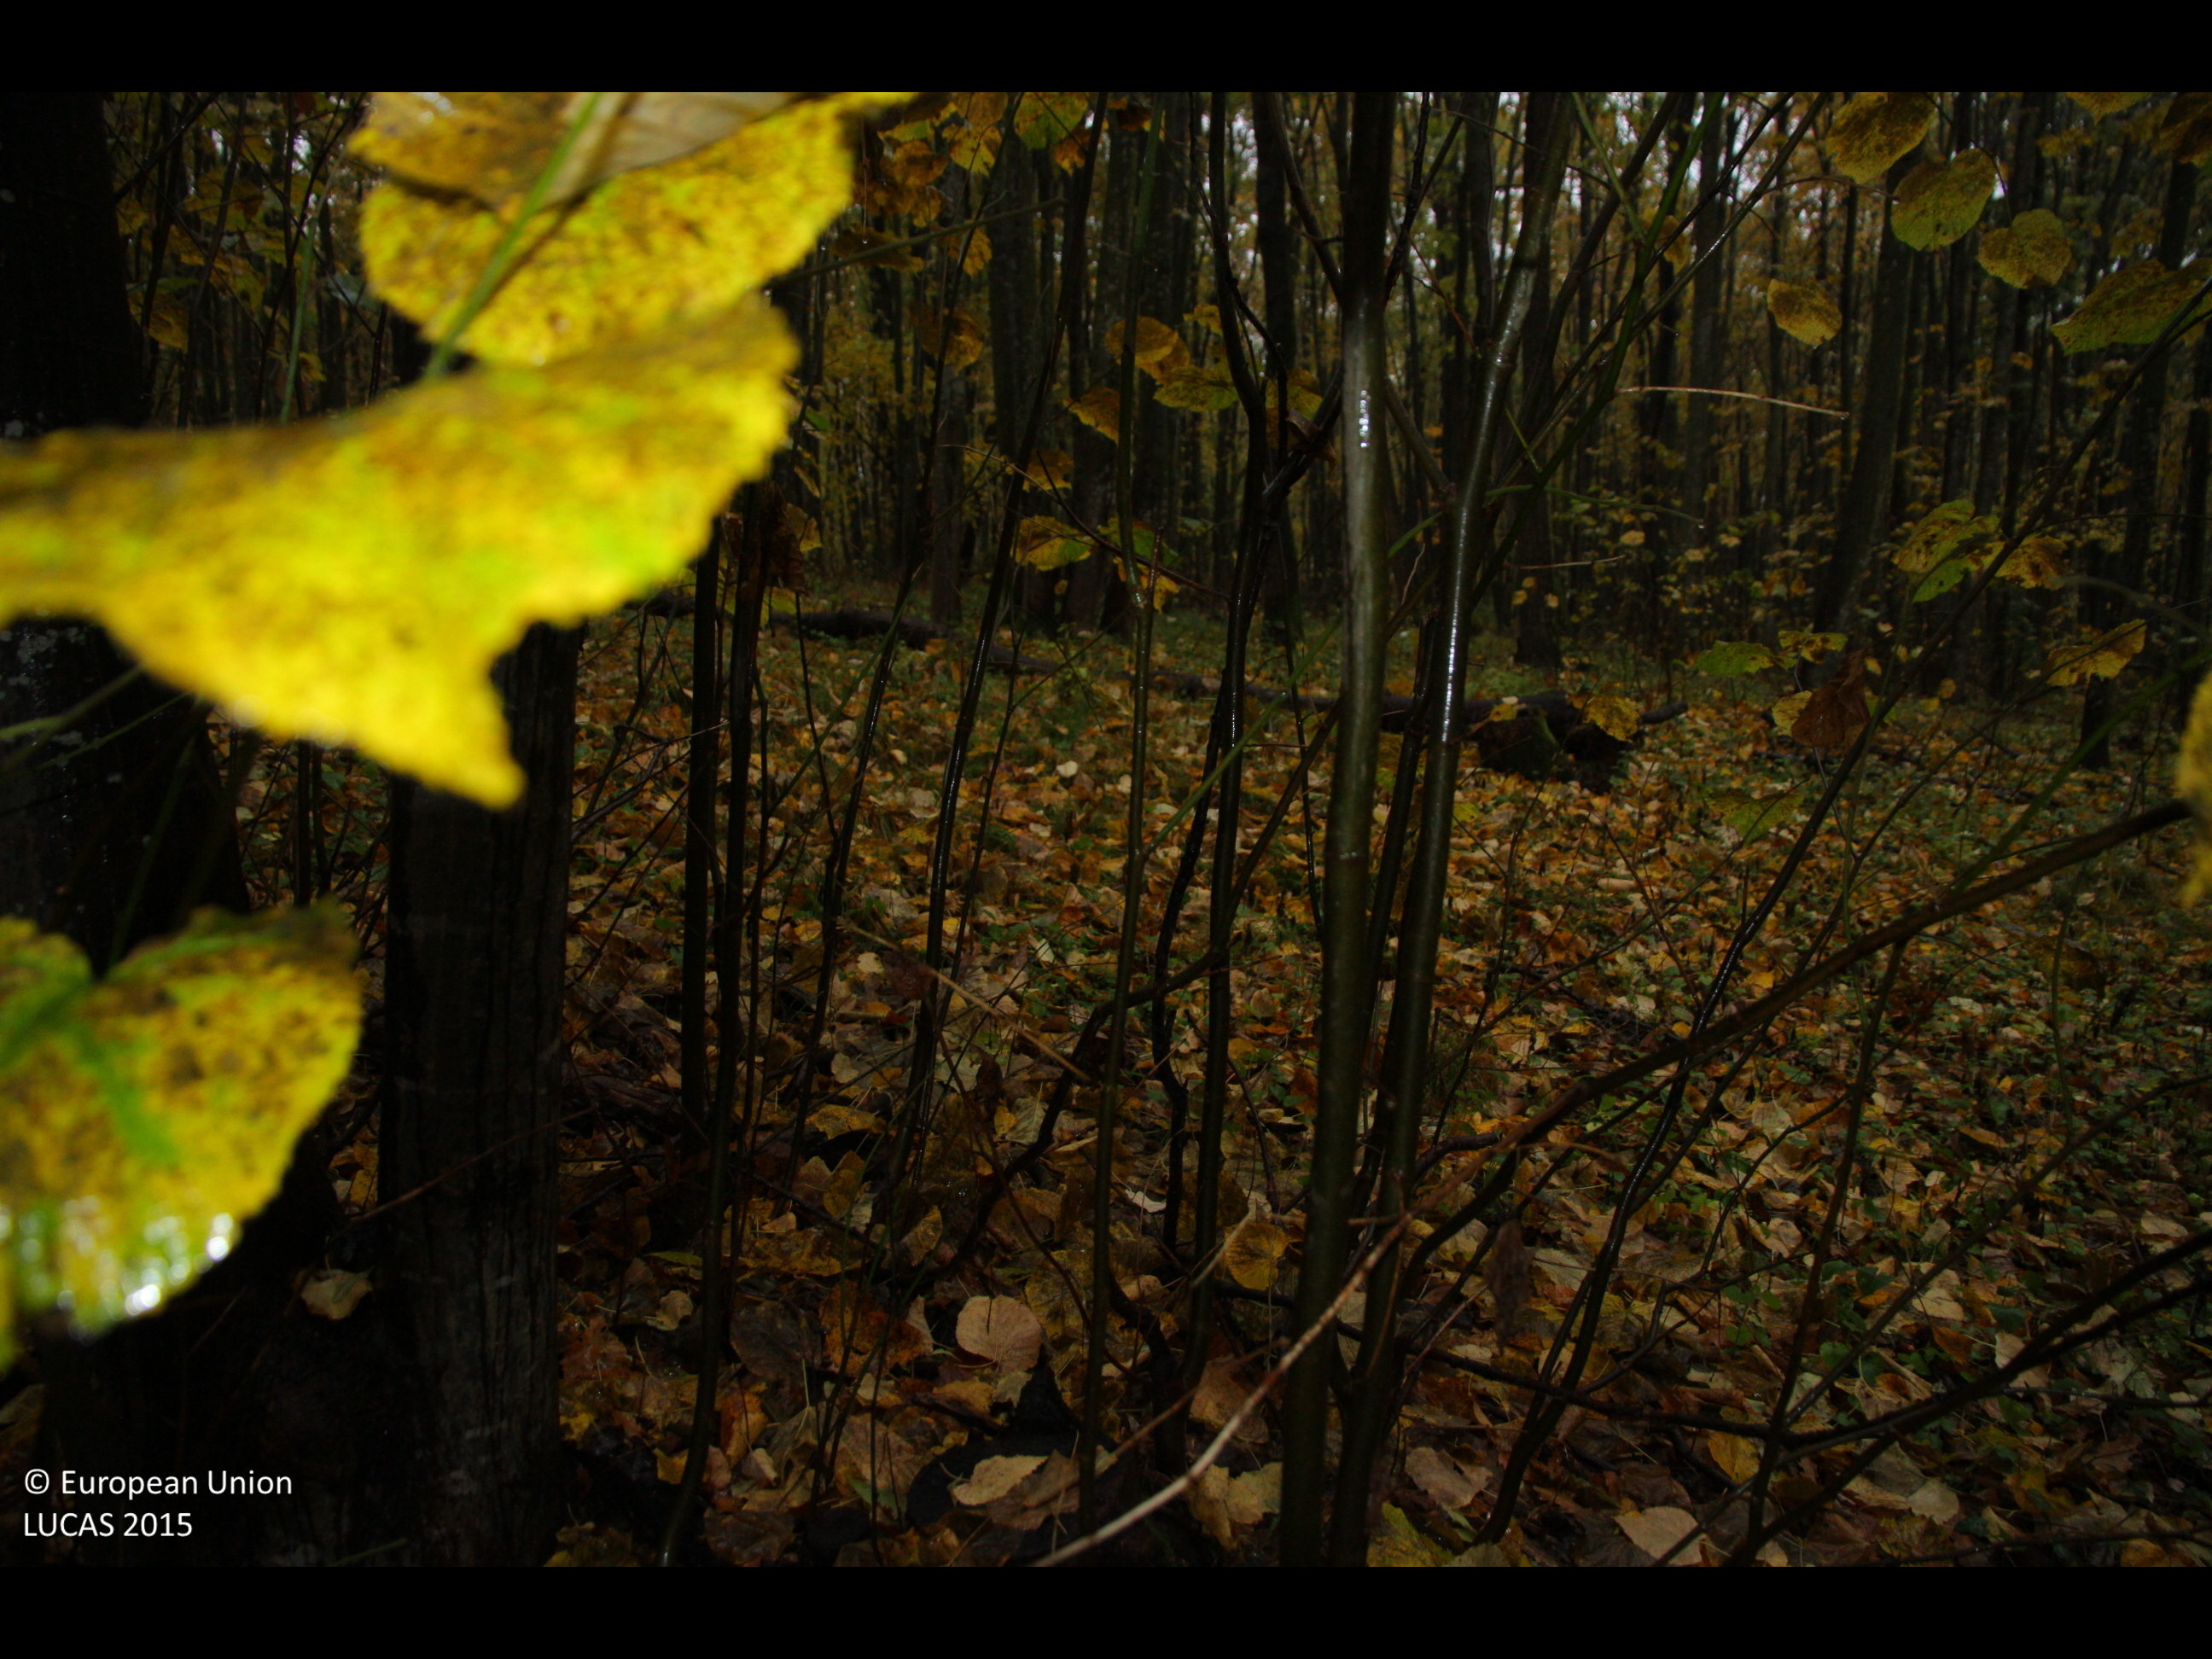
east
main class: Woodland
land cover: Broadleaved woodland
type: beech forest
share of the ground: > 75 %
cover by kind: broadleaved forest trees 100 %
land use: Forestry
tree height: > 5 m
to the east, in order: Broadleaved woodland; Tracks; Broadleaved woodland
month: October
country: BG
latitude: 43.7595
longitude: 26.4650
